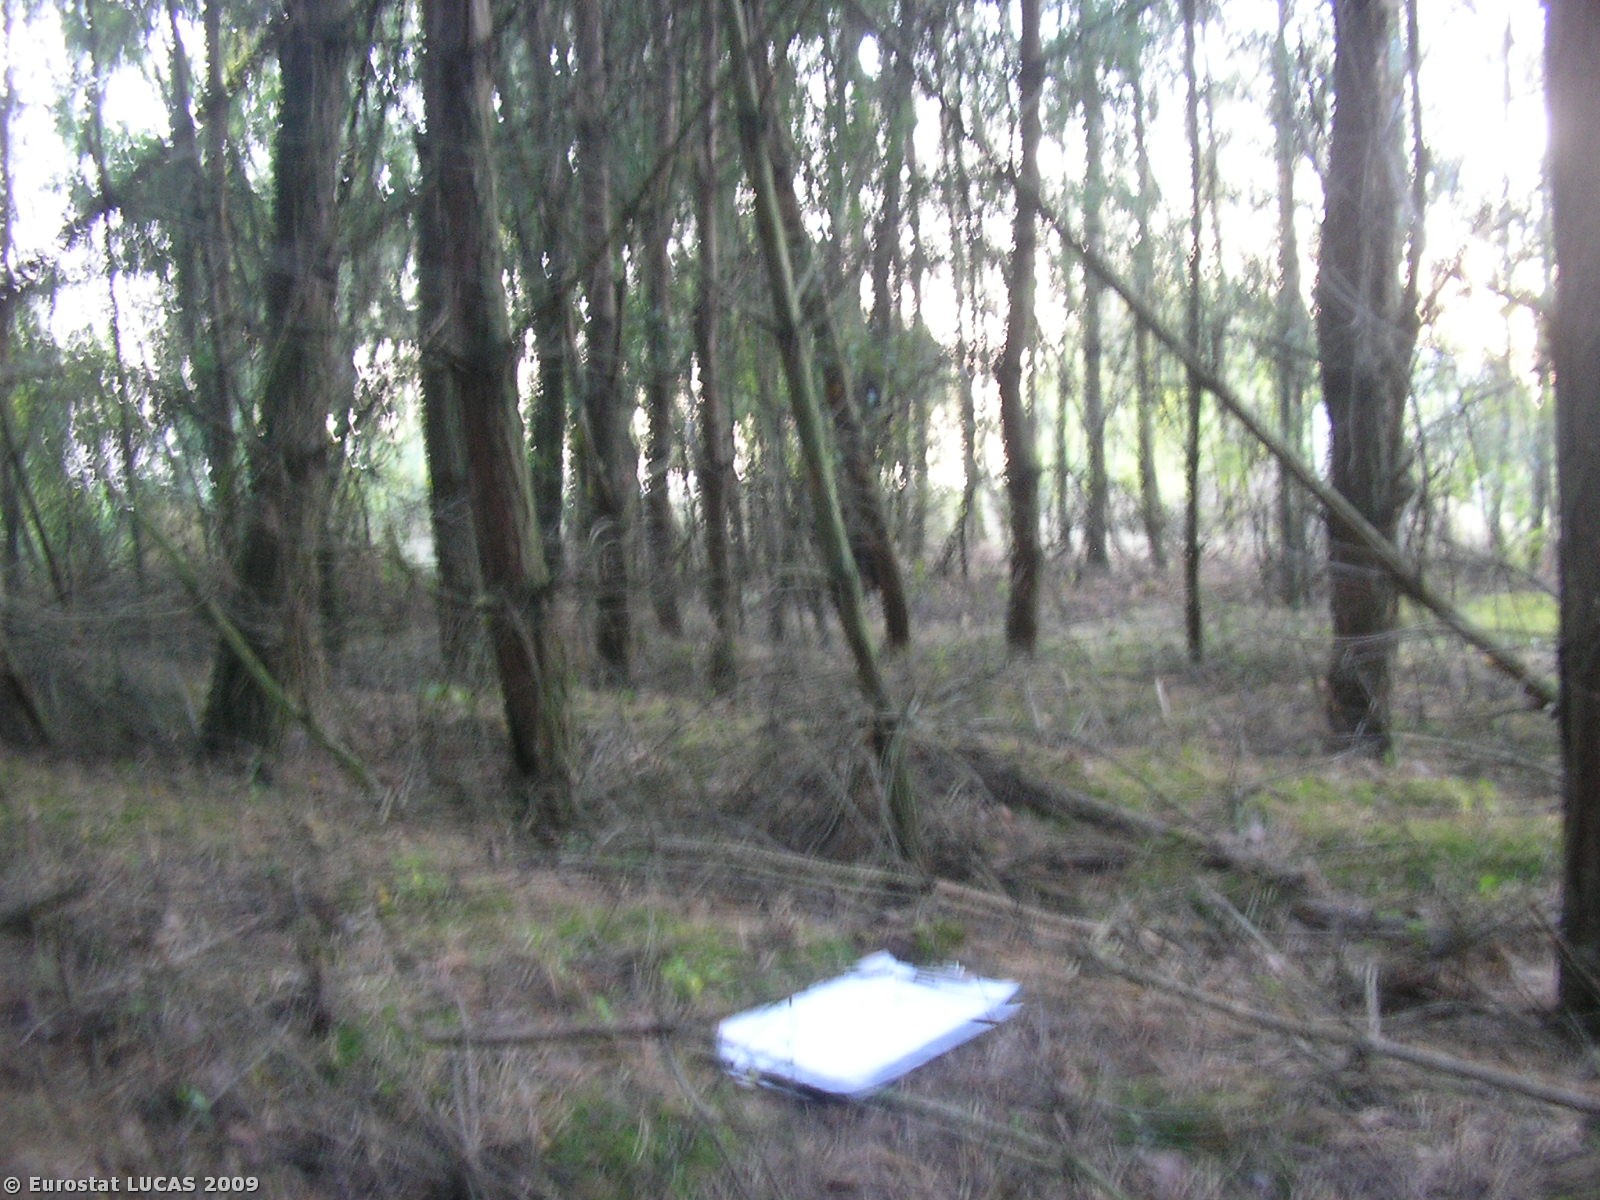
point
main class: Woodland
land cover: Coniferous woodland
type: hemiboreal forest and nemoral coniferous forest and mixed broadleaved-coniferous forest
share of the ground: > 75 %
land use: Forestry
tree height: > 5 m
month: September
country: PL
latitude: 51.7083
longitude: 21.1168
